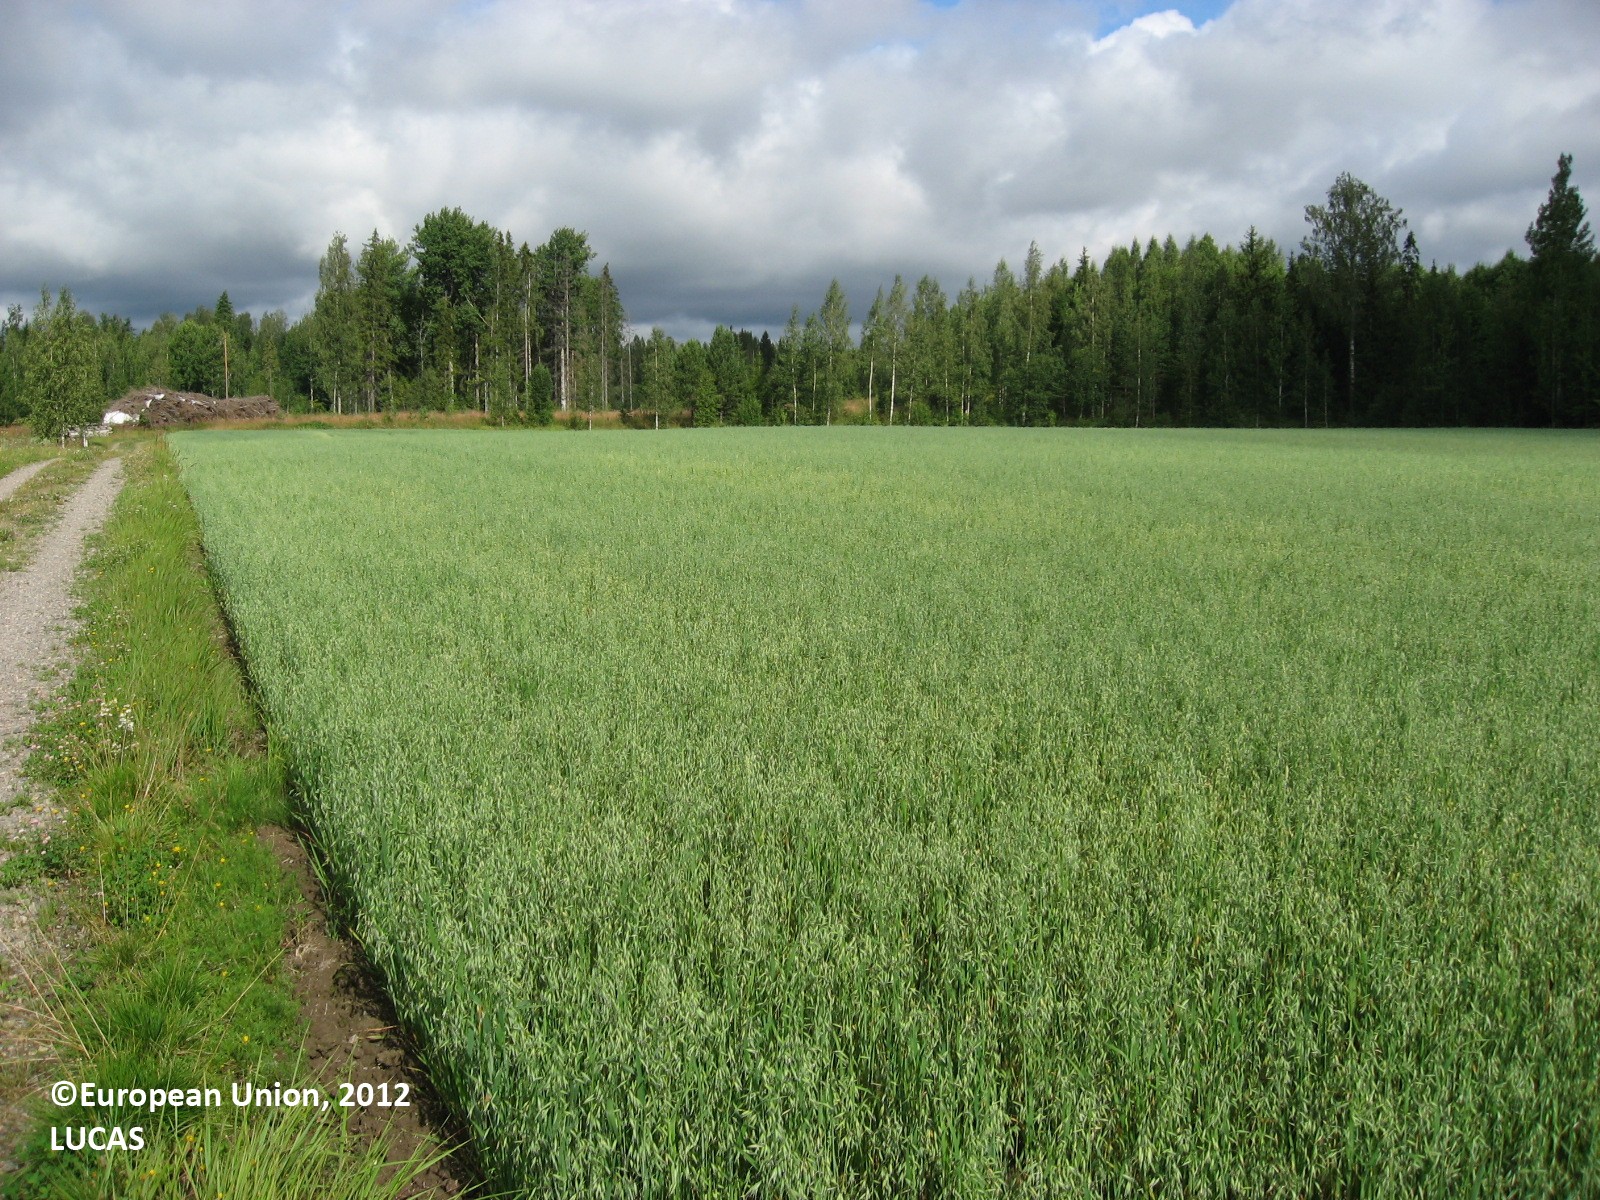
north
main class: Cropland
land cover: Oats
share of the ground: > 75 %
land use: Agriculture (excluding fallow land and kitchen gardens)
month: August
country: FI
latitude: 60.6445
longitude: 25.4702
